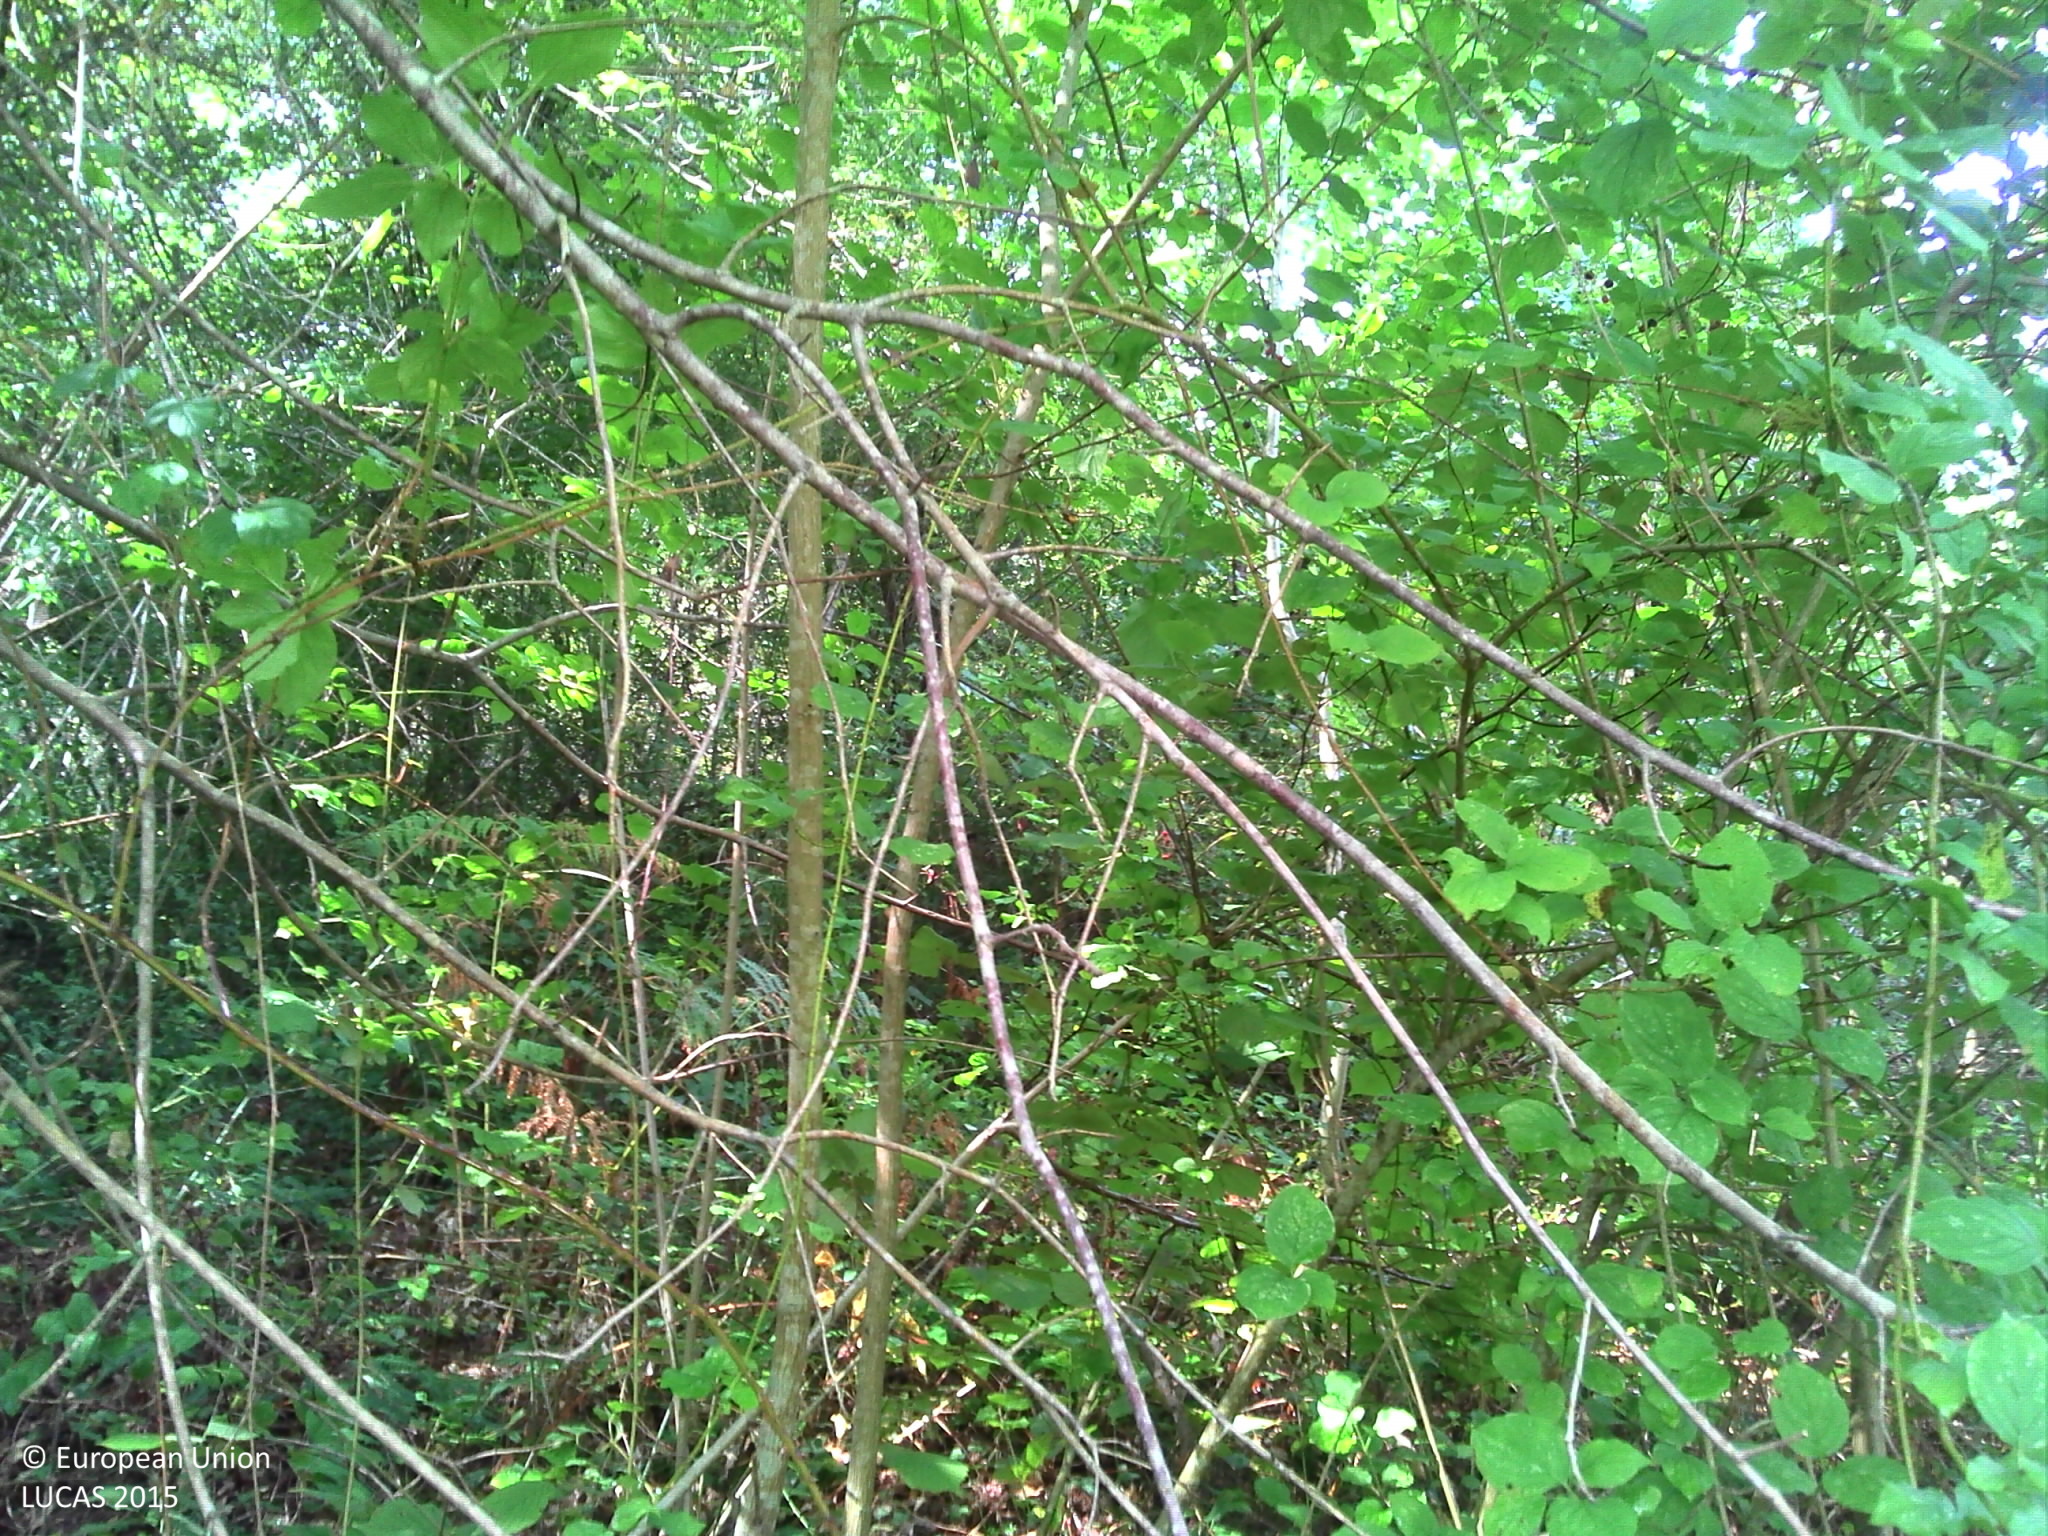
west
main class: Woodland
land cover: Broadleaved woodland
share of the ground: > 75 %
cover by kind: broadleaved forest trees 60 %, shrubs 30 %, herbaceous plants 5 %, lichens and mosses 5 %
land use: Forestry
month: September
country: FR
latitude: 43.1972
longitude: -1.0256
